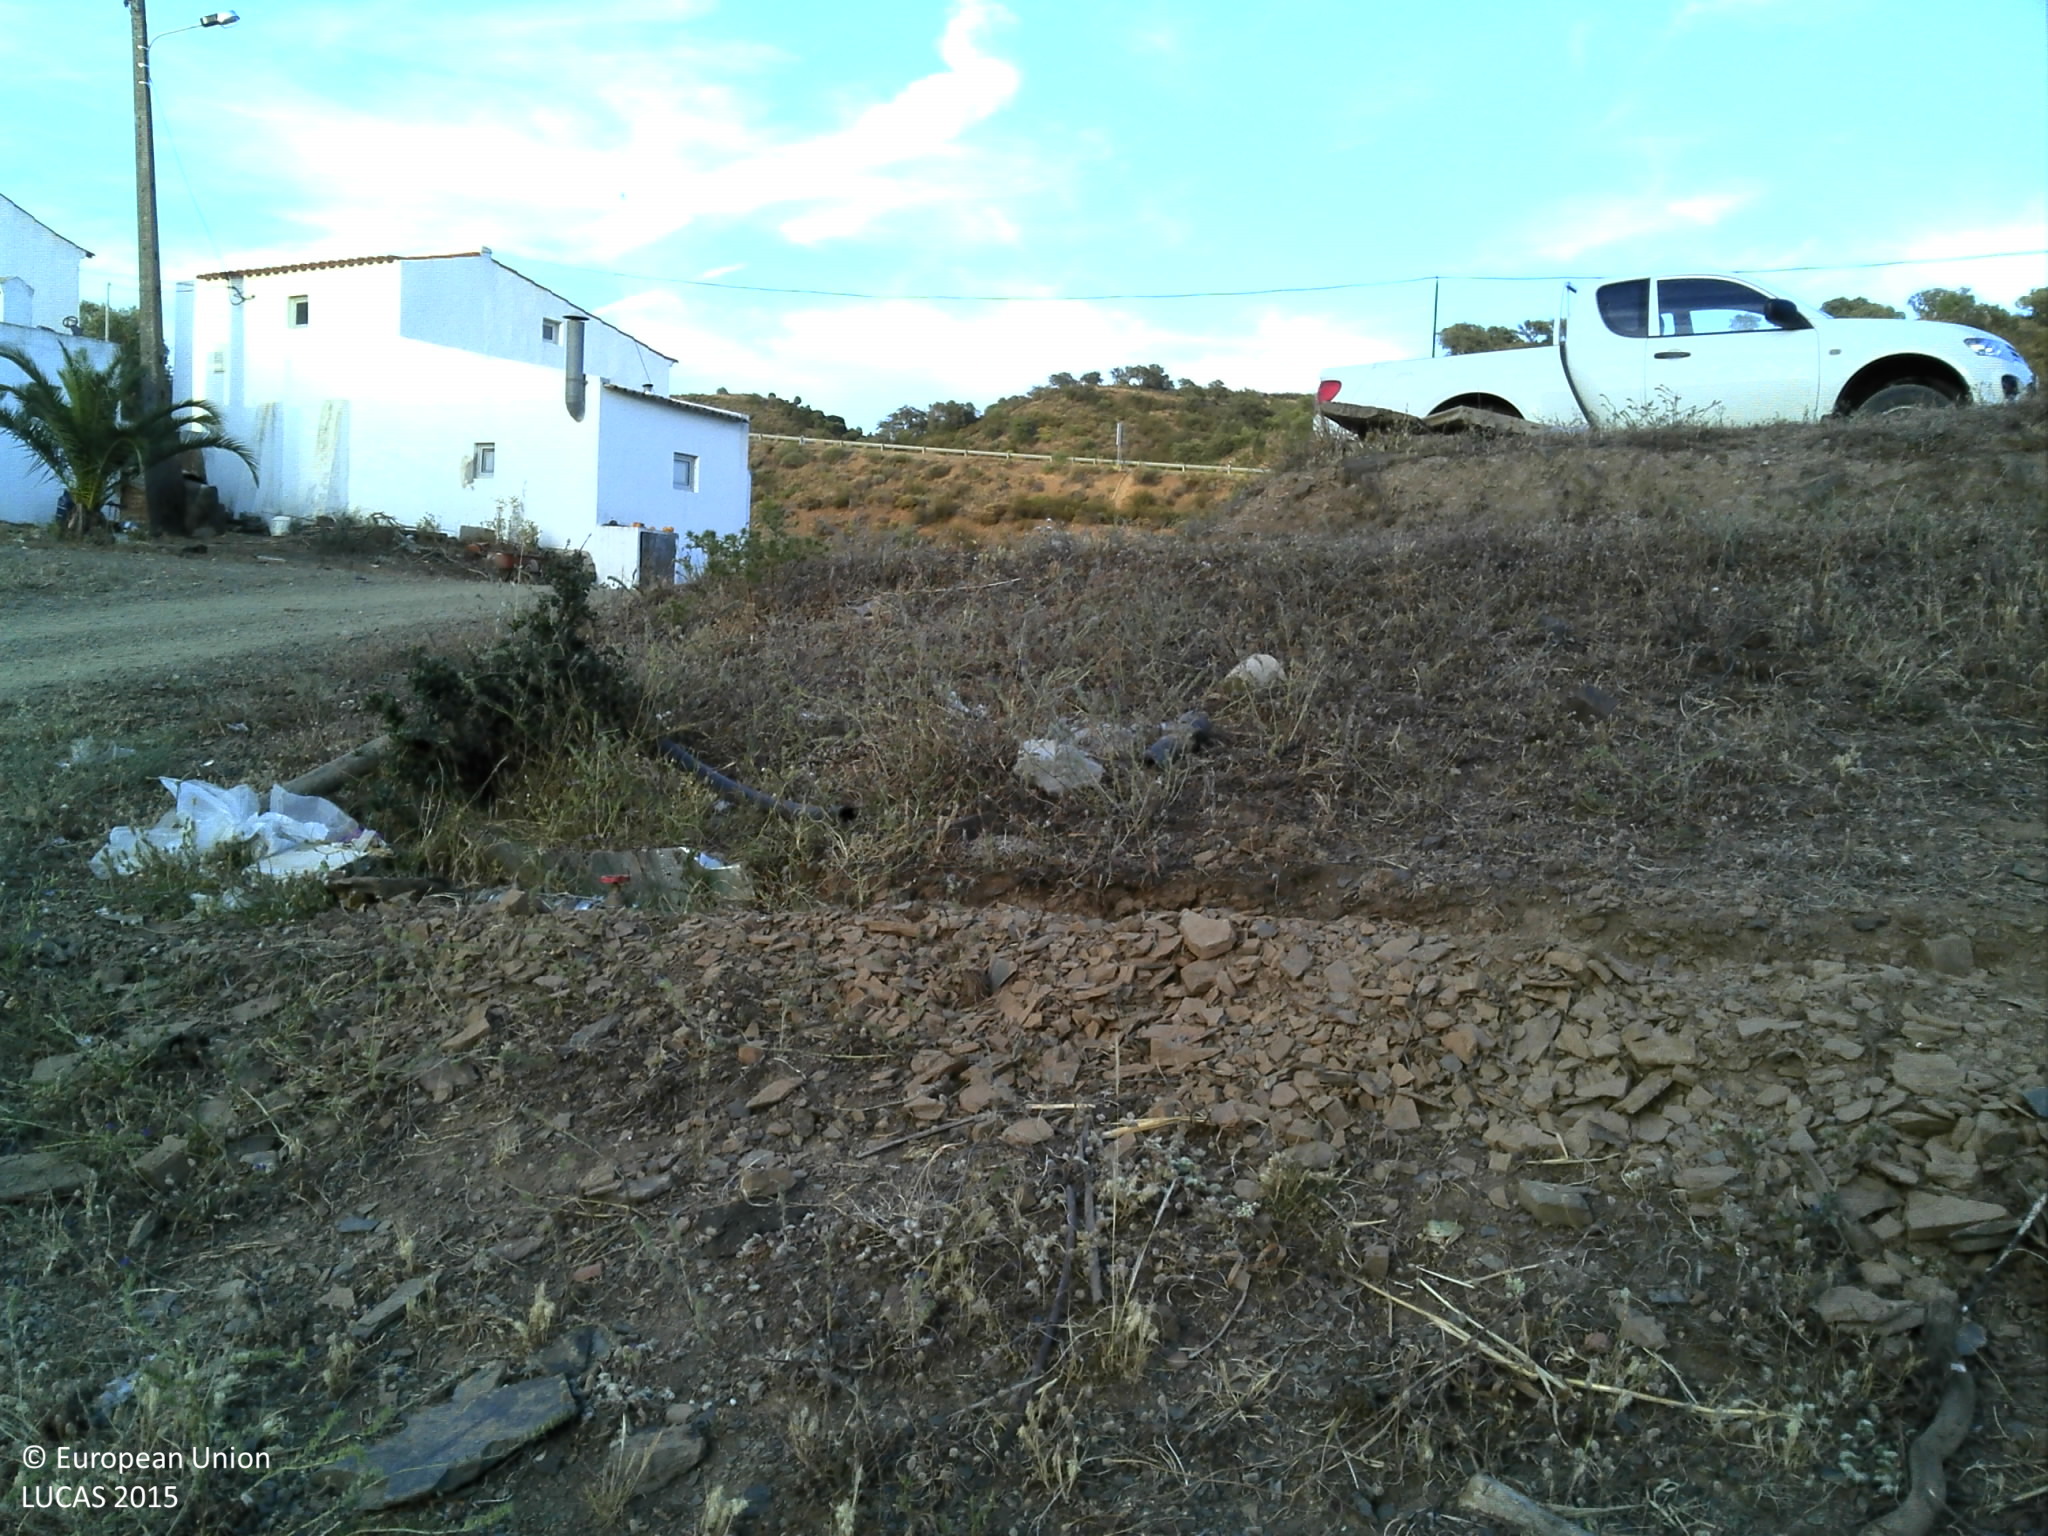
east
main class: Grassland
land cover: Grassland with sparse tree/shrub cover
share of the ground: 25 - 50 %
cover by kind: herbaceous plants 45 %, unconsolidated bare surface 40 %, broadleaved forest trees 5 %
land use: Abandoned areas
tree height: < 5 m
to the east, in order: Grassland with sparse tree/shrub cover; Tracks; Oranges; Grassland without tree/shrub cover; Grassland with sparse tree/shrub cover; Inland fresh running water; Grassland with sparse tree/shrub cover; Fences; Shrubland without tree cover; Paved roads, cycling and walking lanes; Grassland without tree/shrub cover; Fences; Paved roads, cycling and walking lanes; Shrubland with sparse tree cover; Rock outcrops; Shrubland with sparse tree cover; Rock outcrops; Shrubland with sparse tree cover
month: May
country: PT
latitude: 37.2769
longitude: -7.4969
